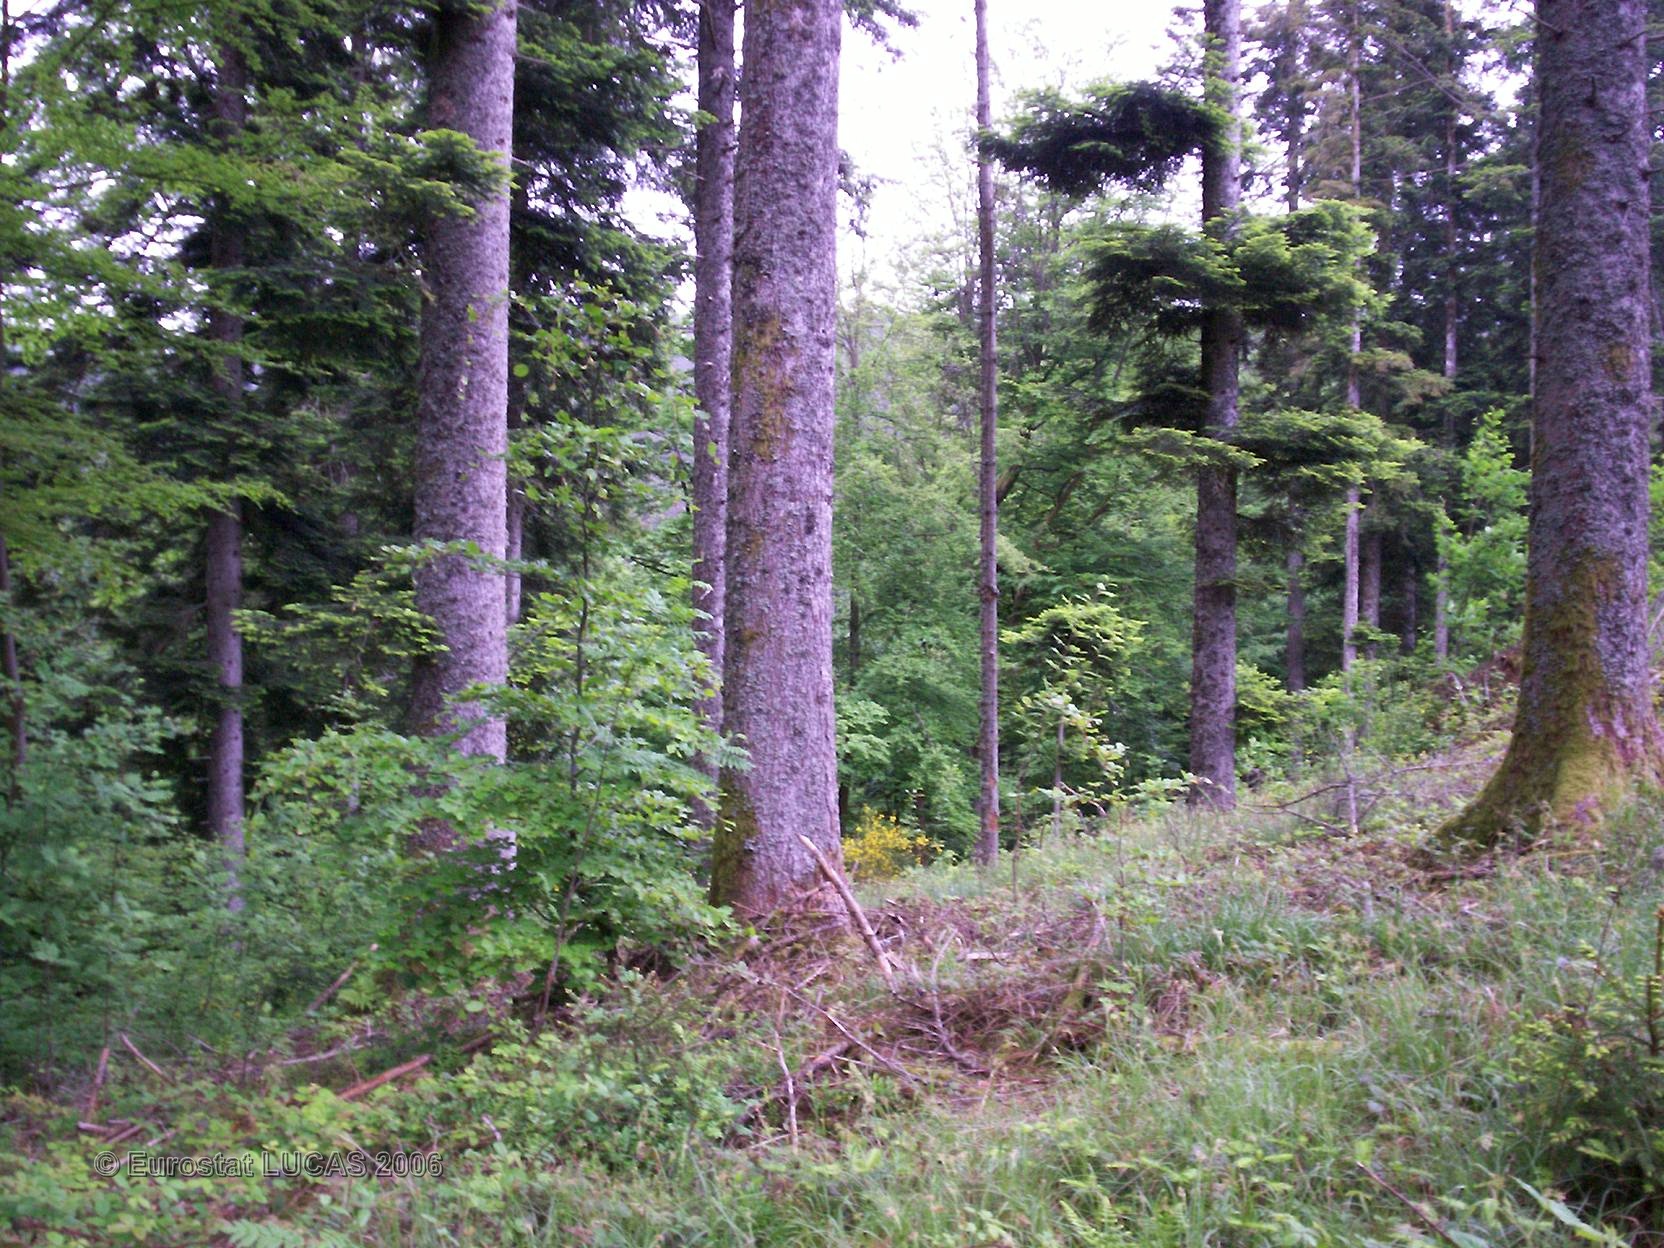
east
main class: Woodland
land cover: Mixed forest
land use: Forestry
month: May
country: FR
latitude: 48.1588
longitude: 6.7879
